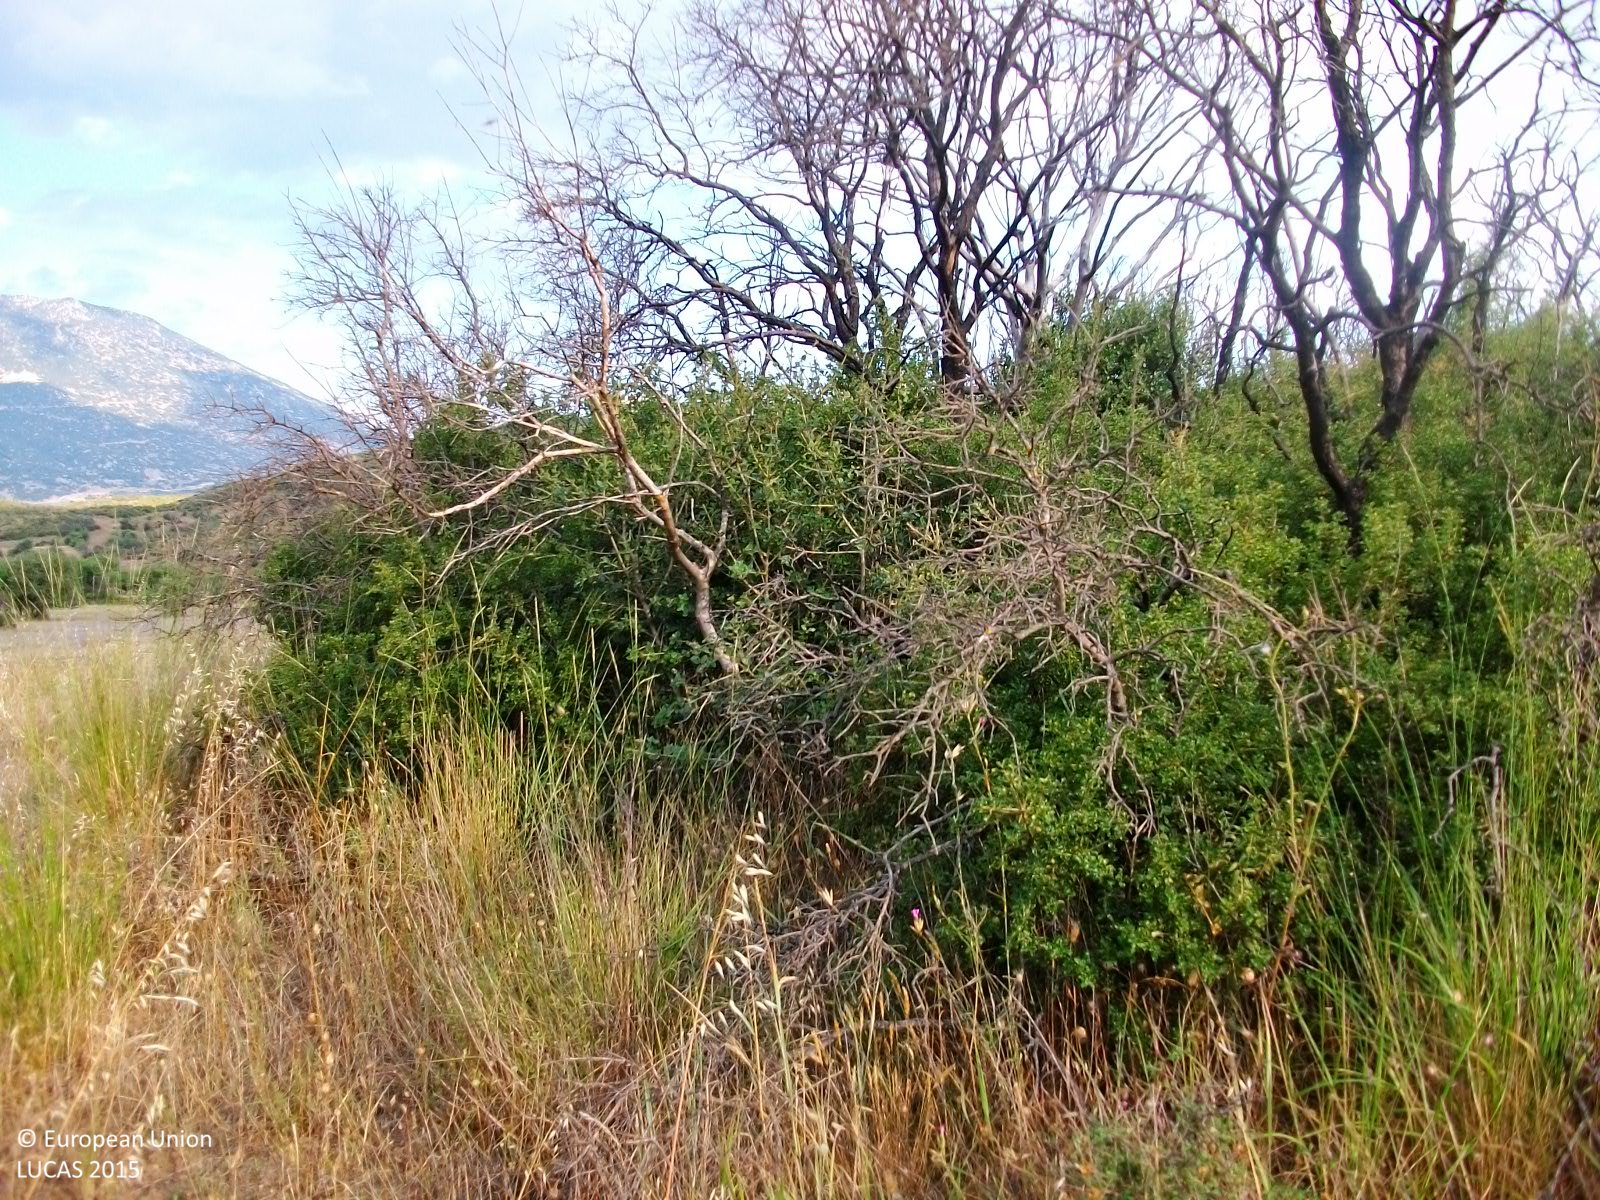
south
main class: Grassland
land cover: Grassland with sparse tree/shrub cover
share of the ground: > 75 %
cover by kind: herbaceous plants 85 %, shrubs 10 %, broadleaved forest trees 5 %
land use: Agriculture (excluding fallow land and kitchen gardens)
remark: Burnt area
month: July
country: GR
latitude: 38.4603
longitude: 22.2011
